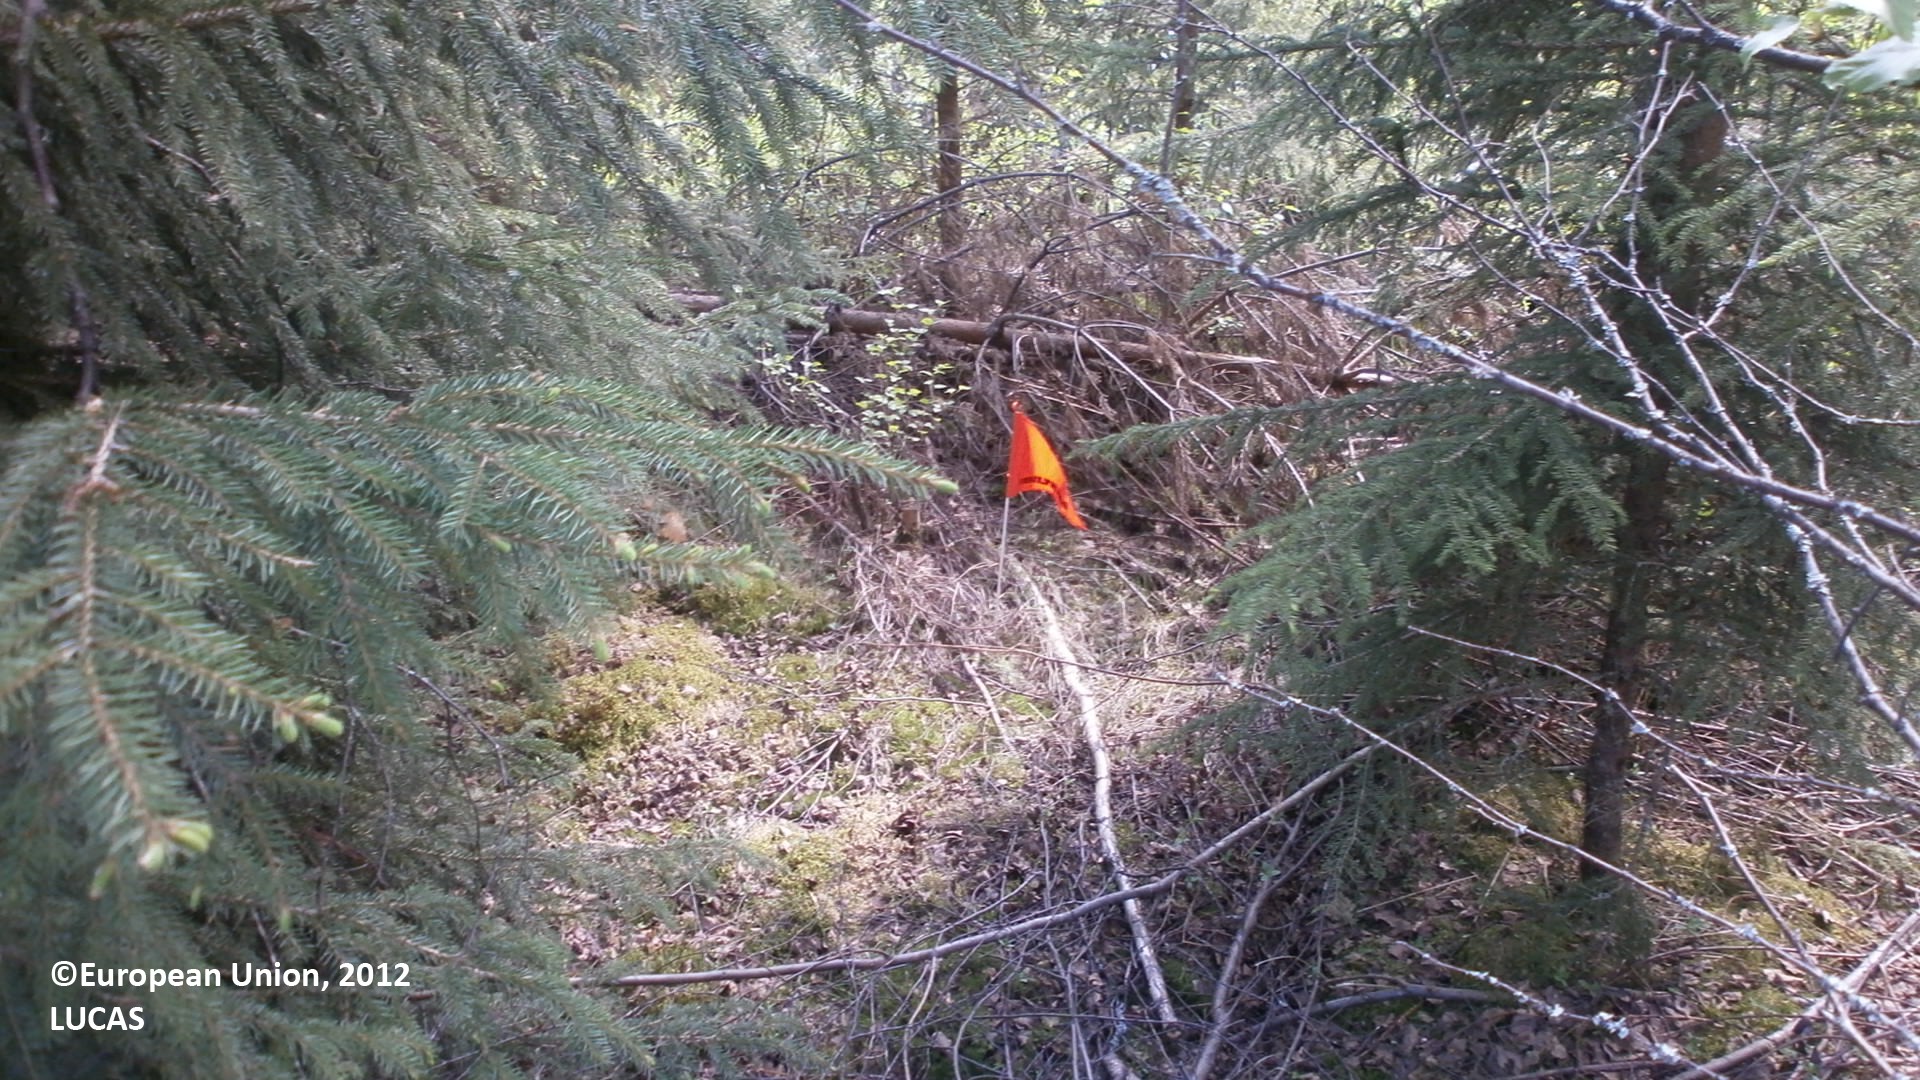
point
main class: Woodland
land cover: Spruce dominated coniferous woodland
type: mire and swamp forests
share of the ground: 50 - 75 %
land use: Forestry
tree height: > 5 m
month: June
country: FI
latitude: 64.5462
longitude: 25.2018
